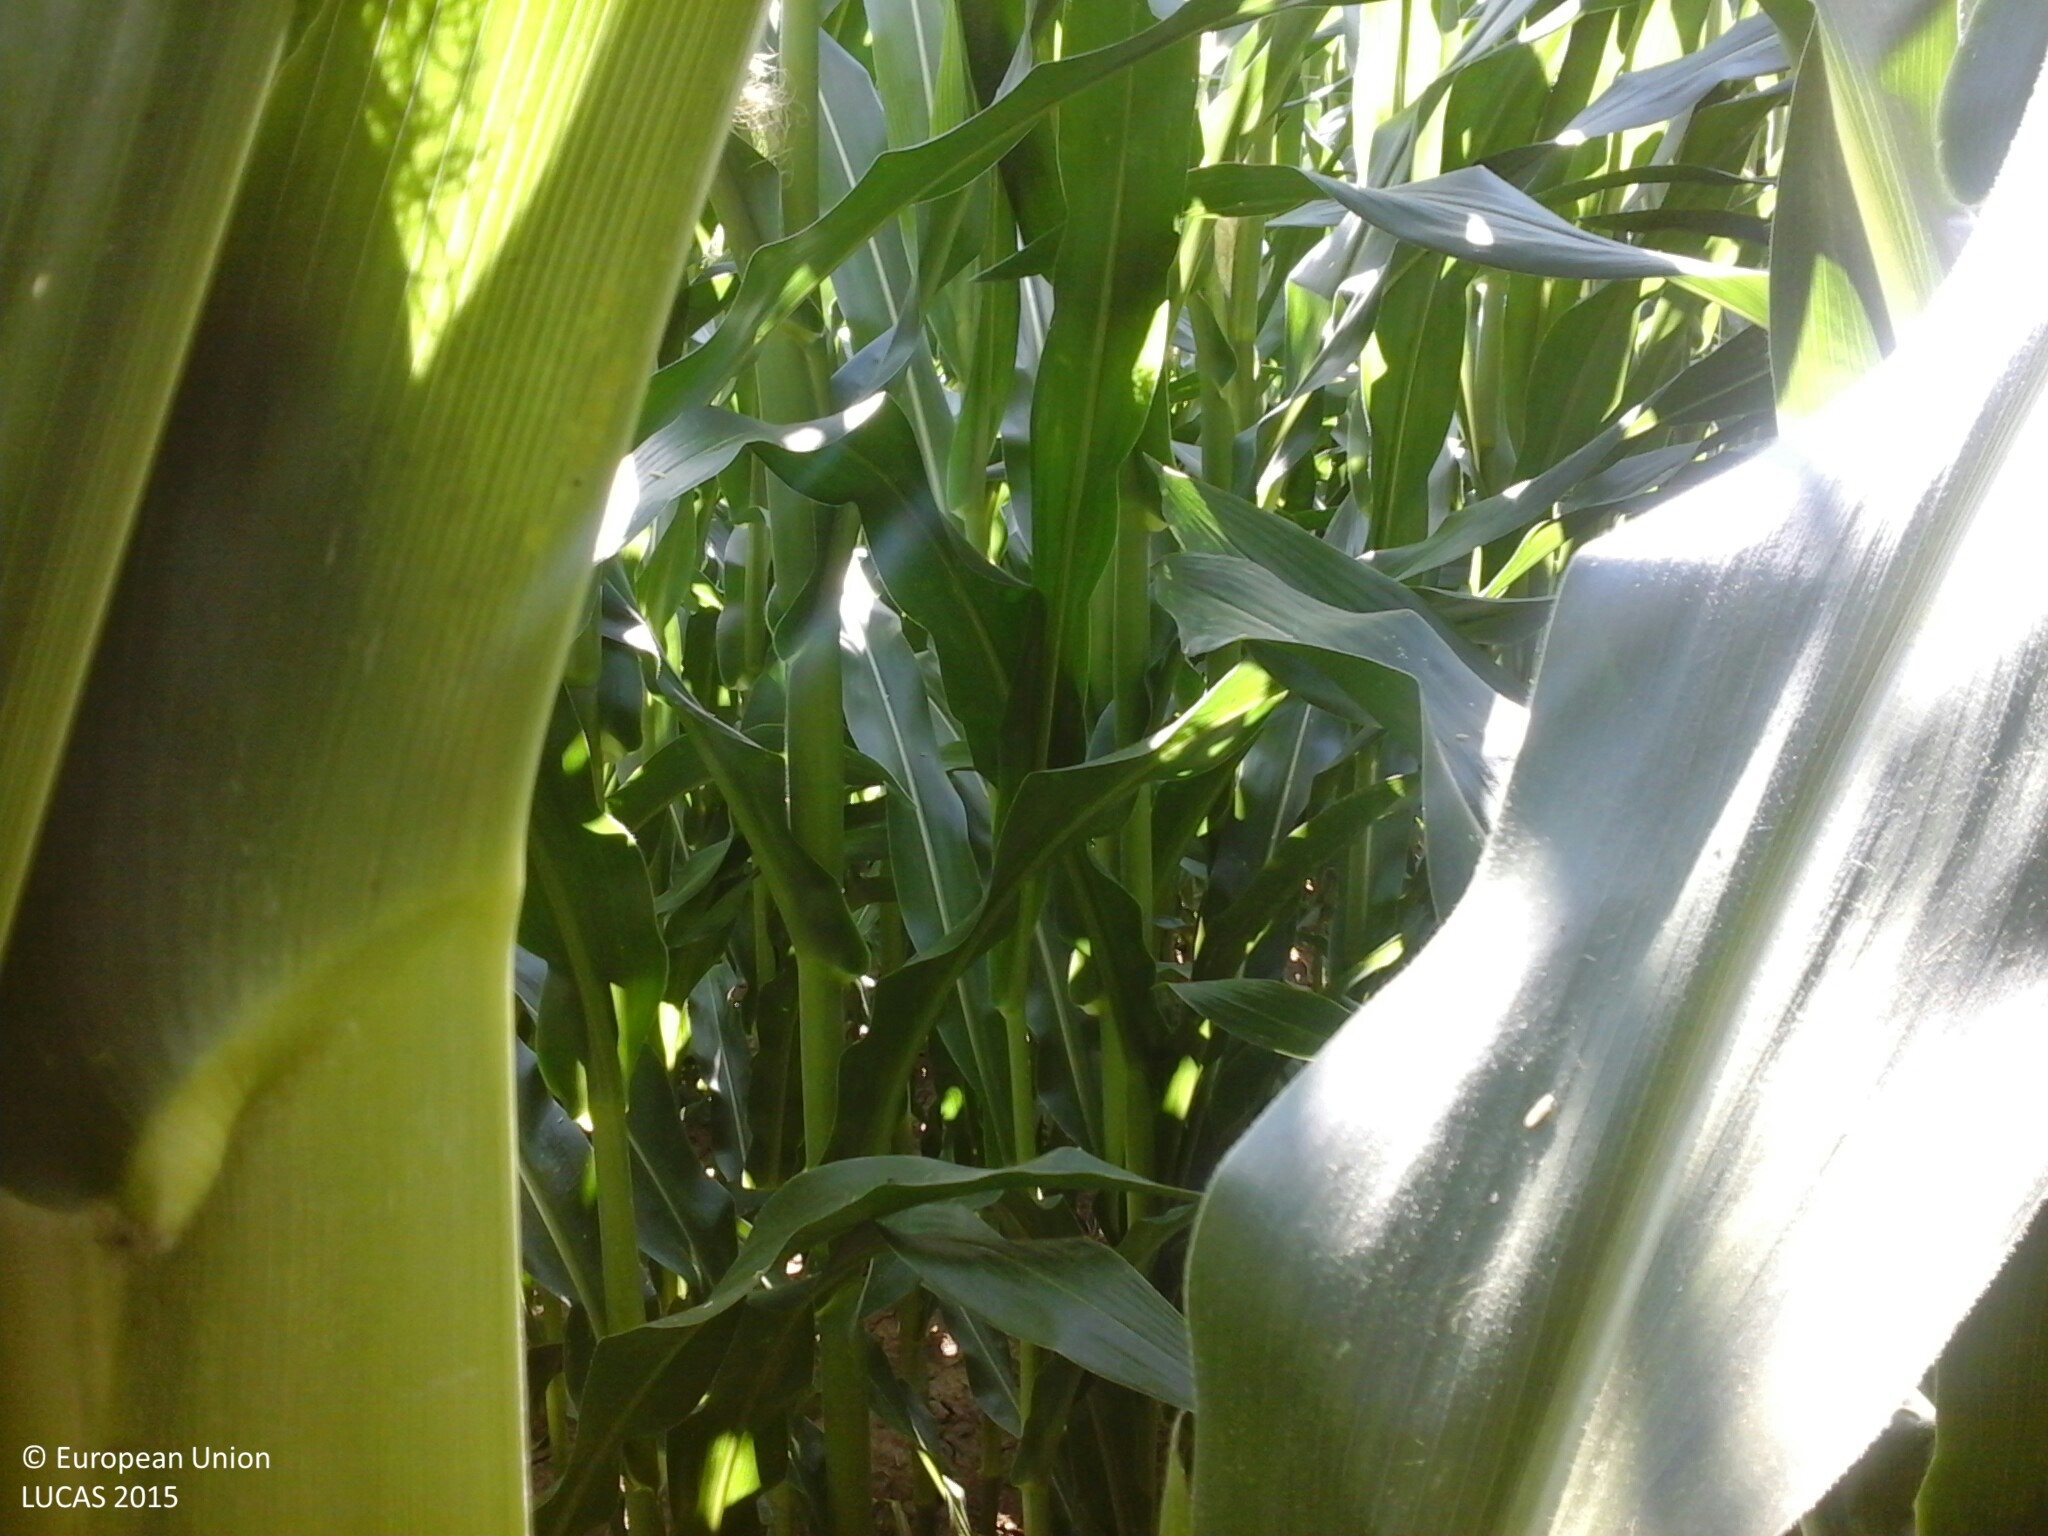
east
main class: Cropland
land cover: Maize
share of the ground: > 75 %
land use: Agriculture (excluding fallow land and kitchen gardens)
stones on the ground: < 10 %
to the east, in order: Maize; Sunflower; Grass margins; Tracks; Grass margins; Fences; Grassland with sparse tree/shrub cover; Grassland without tree/shrub cover; Nurseries
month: July
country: HU
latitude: 48.1058
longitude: 22.3734
